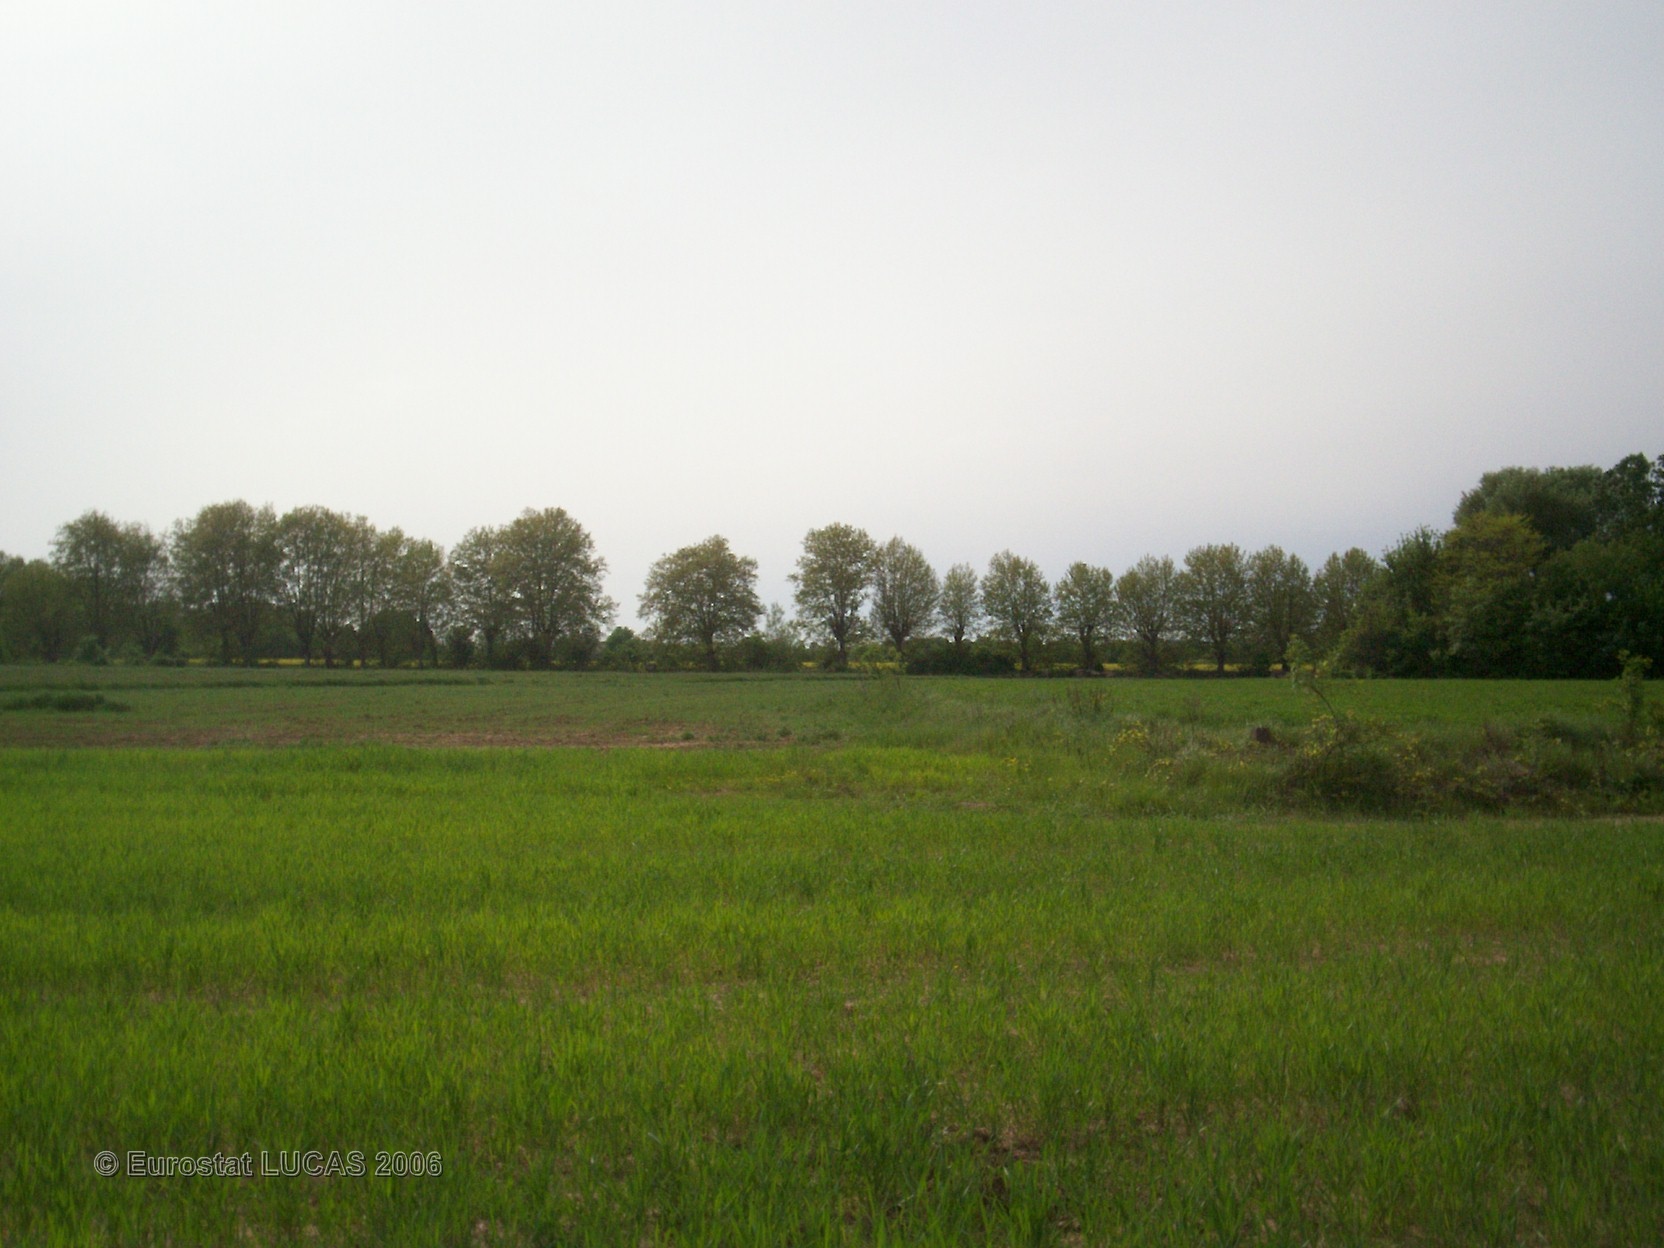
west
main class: Cropland
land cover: Barley
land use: Agriculture (excluding fallow land and kitchen gardens)
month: April
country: FR
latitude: 43.3659
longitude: 3.4570
